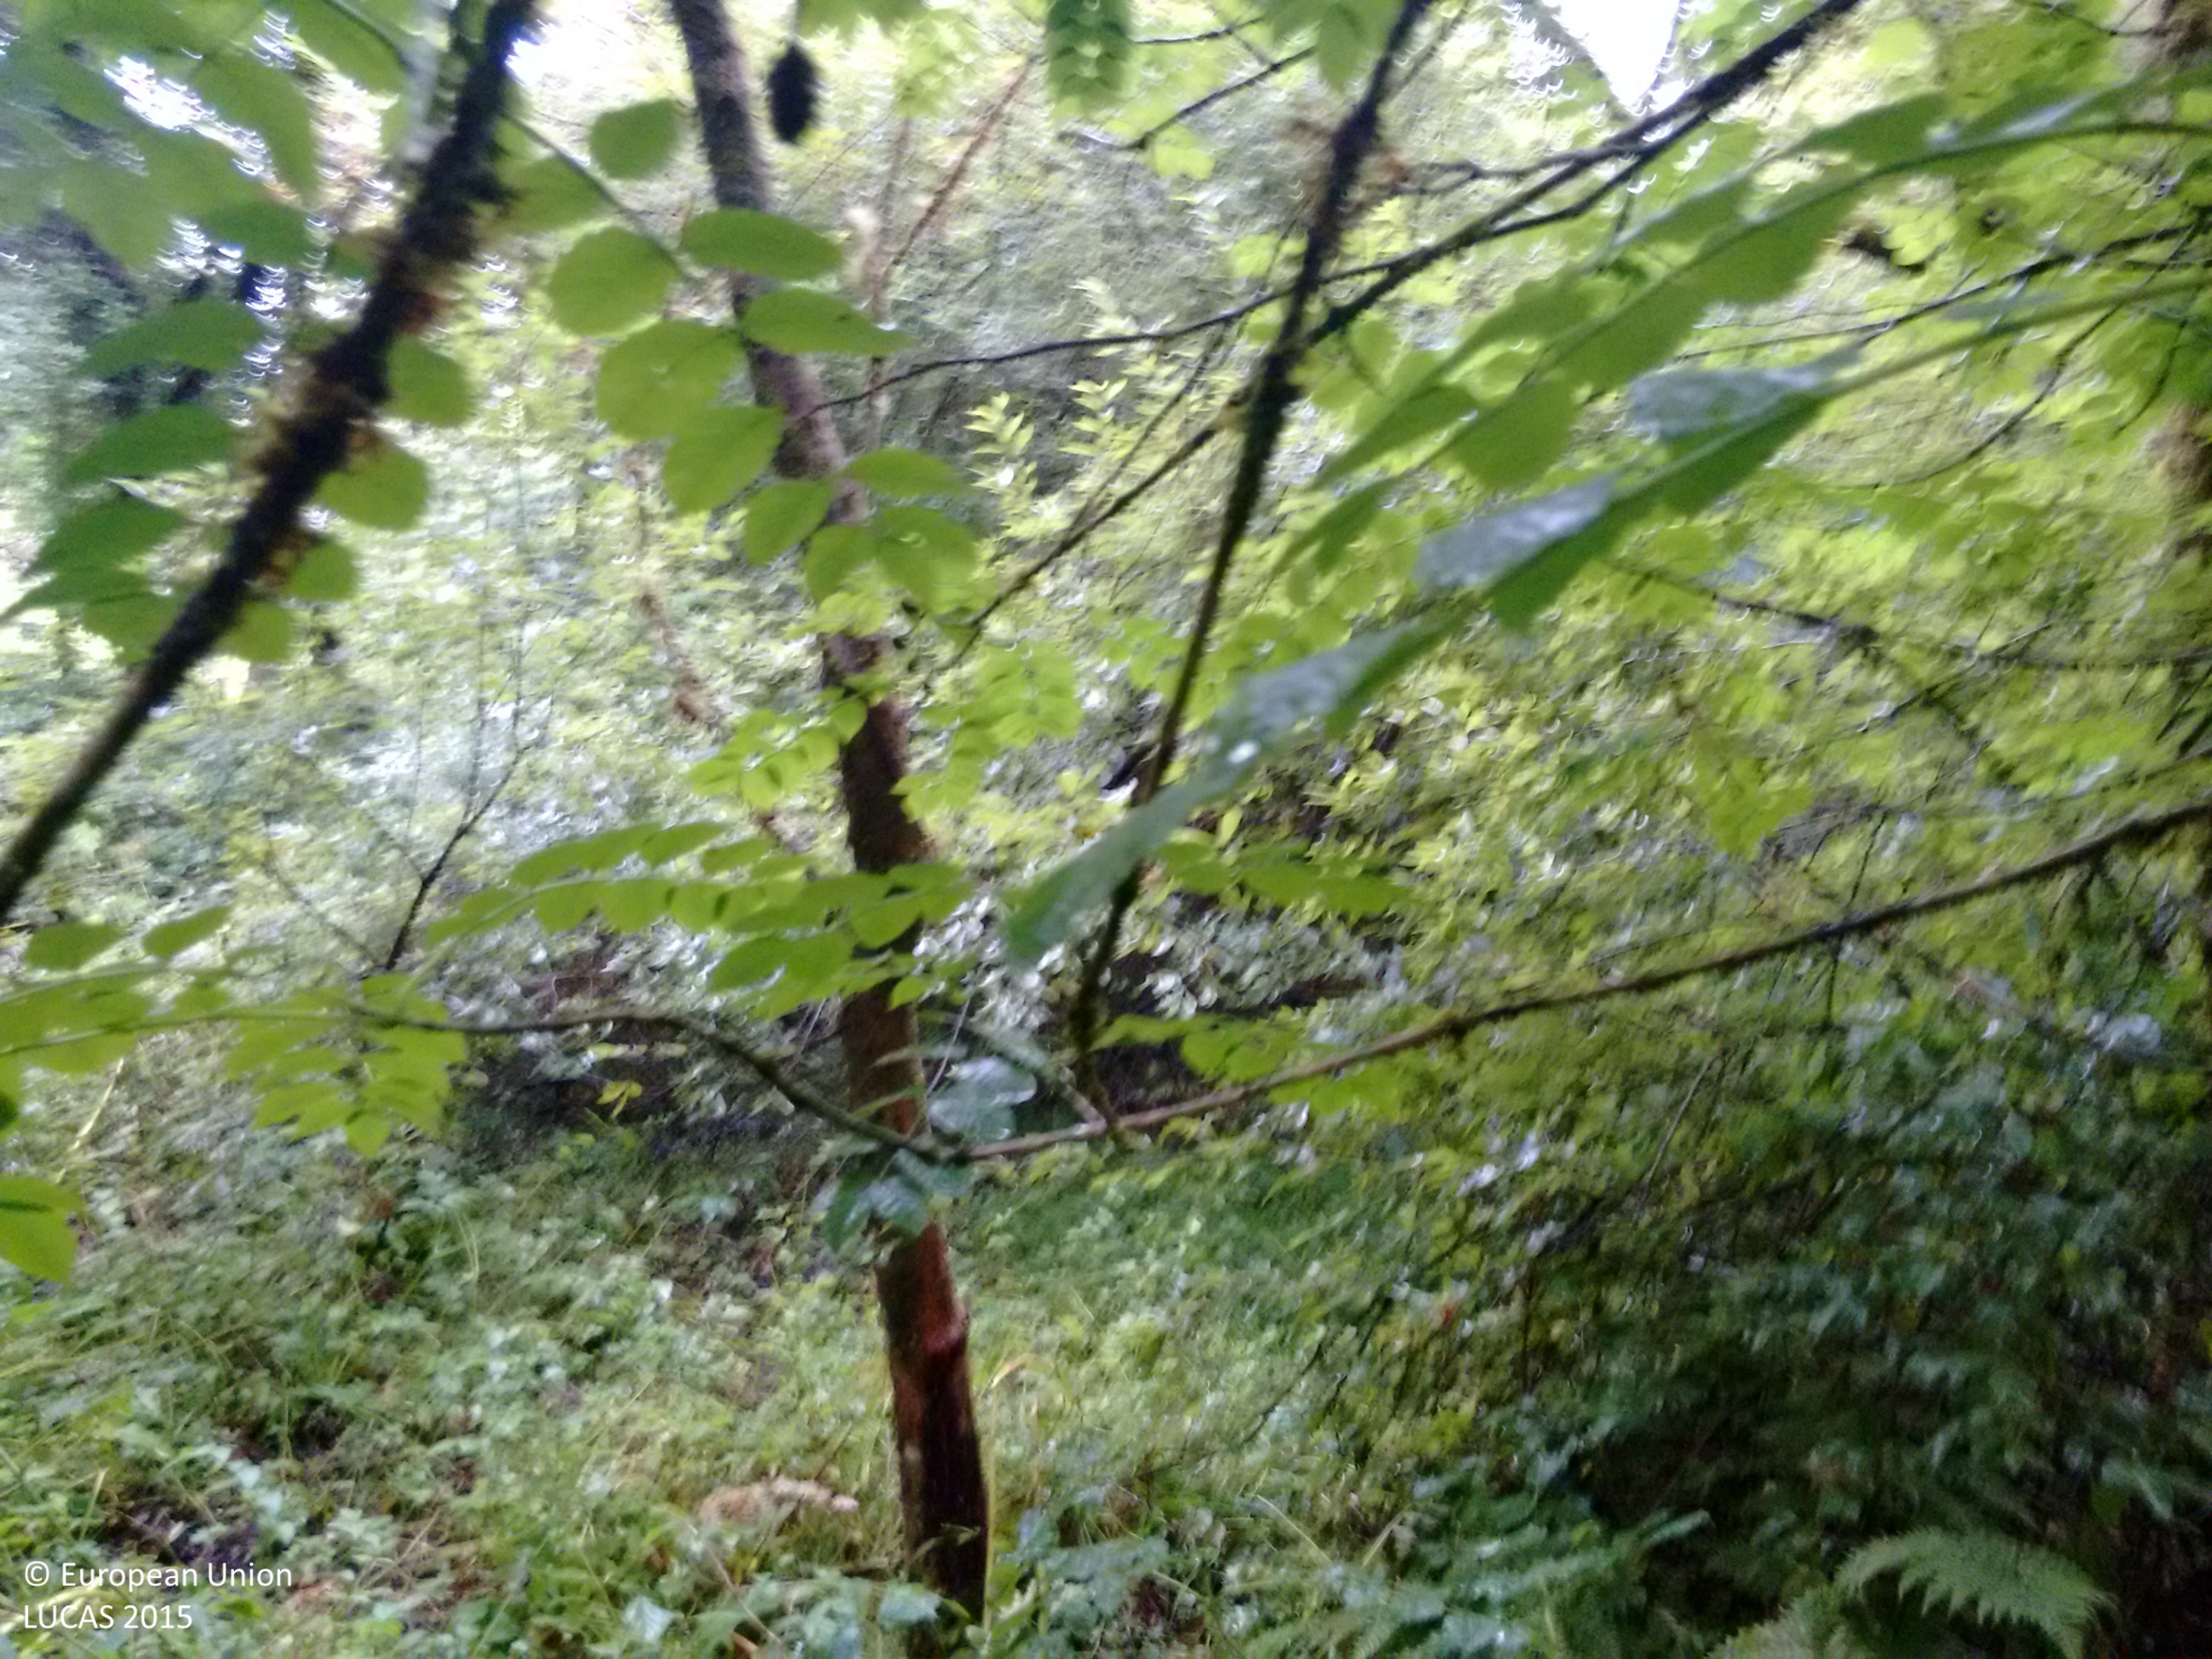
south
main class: Woodland
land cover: Broadleaved woodland
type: floodplain forest
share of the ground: > 75 %
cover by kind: broadleaved forest trees 100 %
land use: Semi-natural and natural areas not in use
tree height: > 5 m
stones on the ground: < 10 %
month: August
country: IE
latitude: 51.8206
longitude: -9.8777
